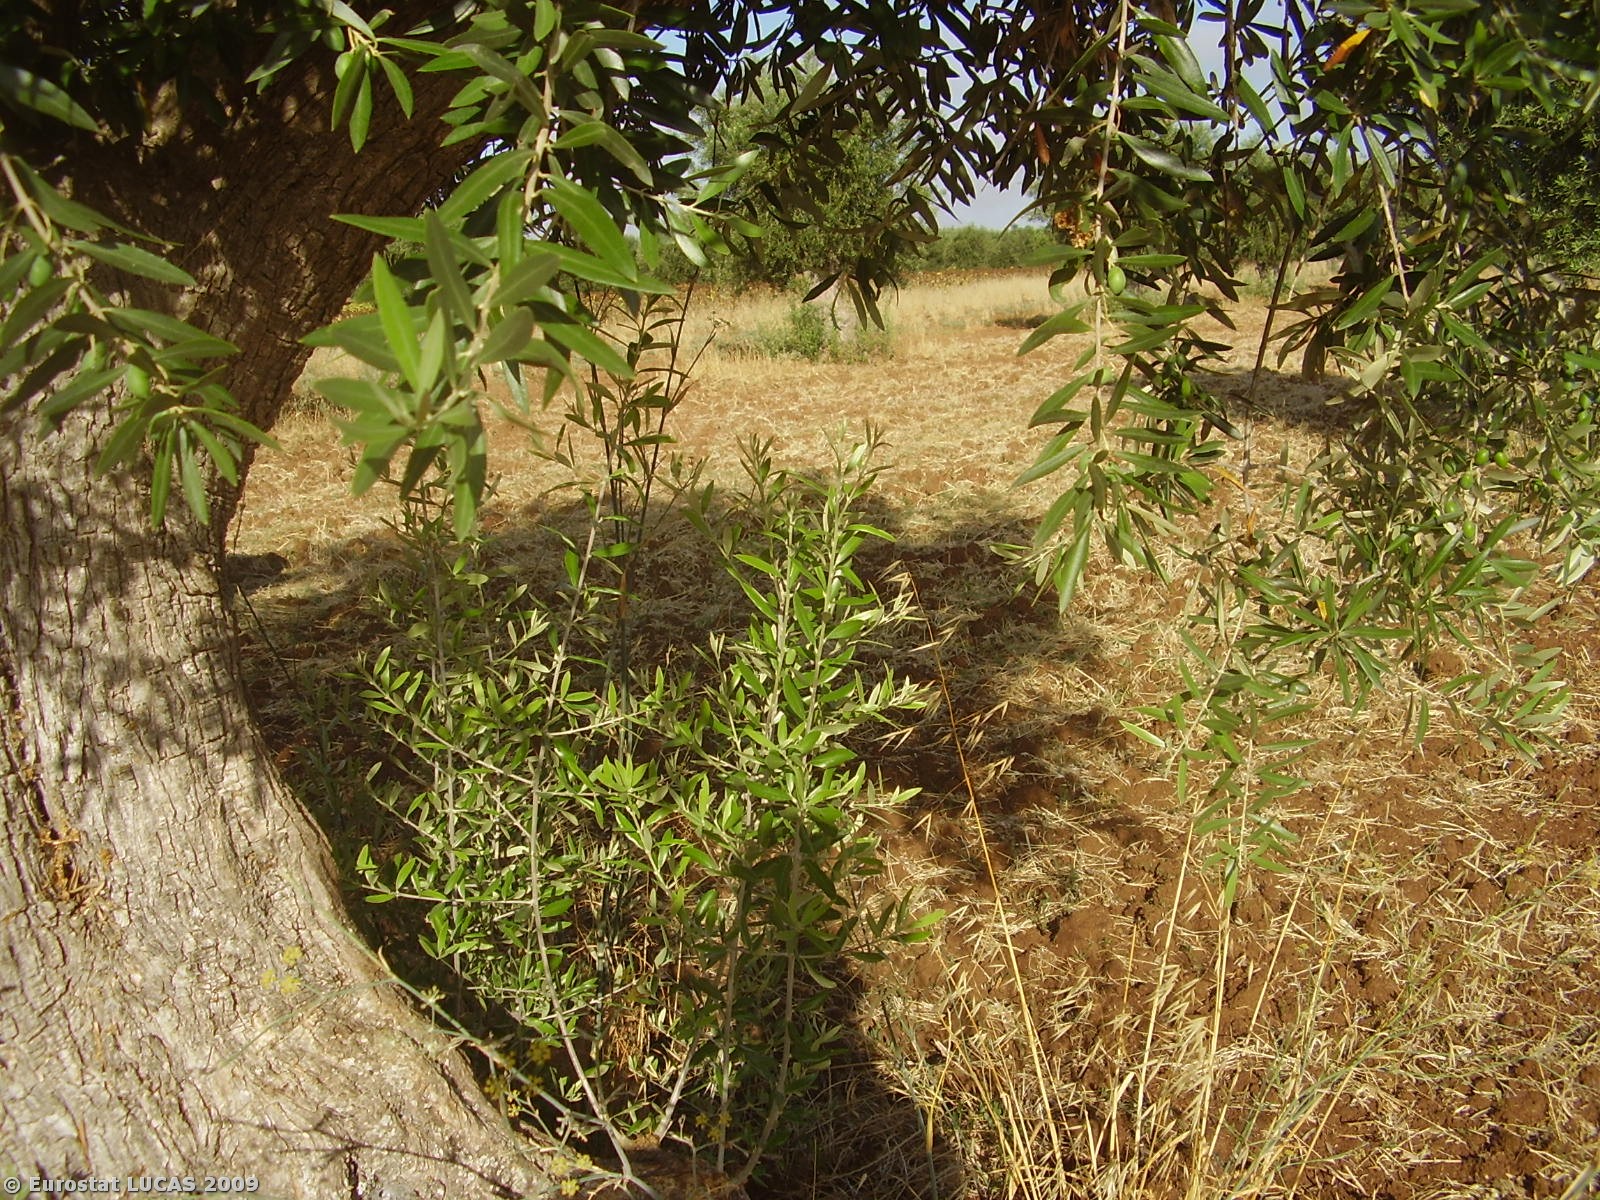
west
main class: Cropland
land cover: Olive groves
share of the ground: 10 - 25 %
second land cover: Oats
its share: > 75 %
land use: Agriculture (excluding fallow land and kitchen gardens)
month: August
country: PT
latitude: 38.0762
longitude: -7.9631
